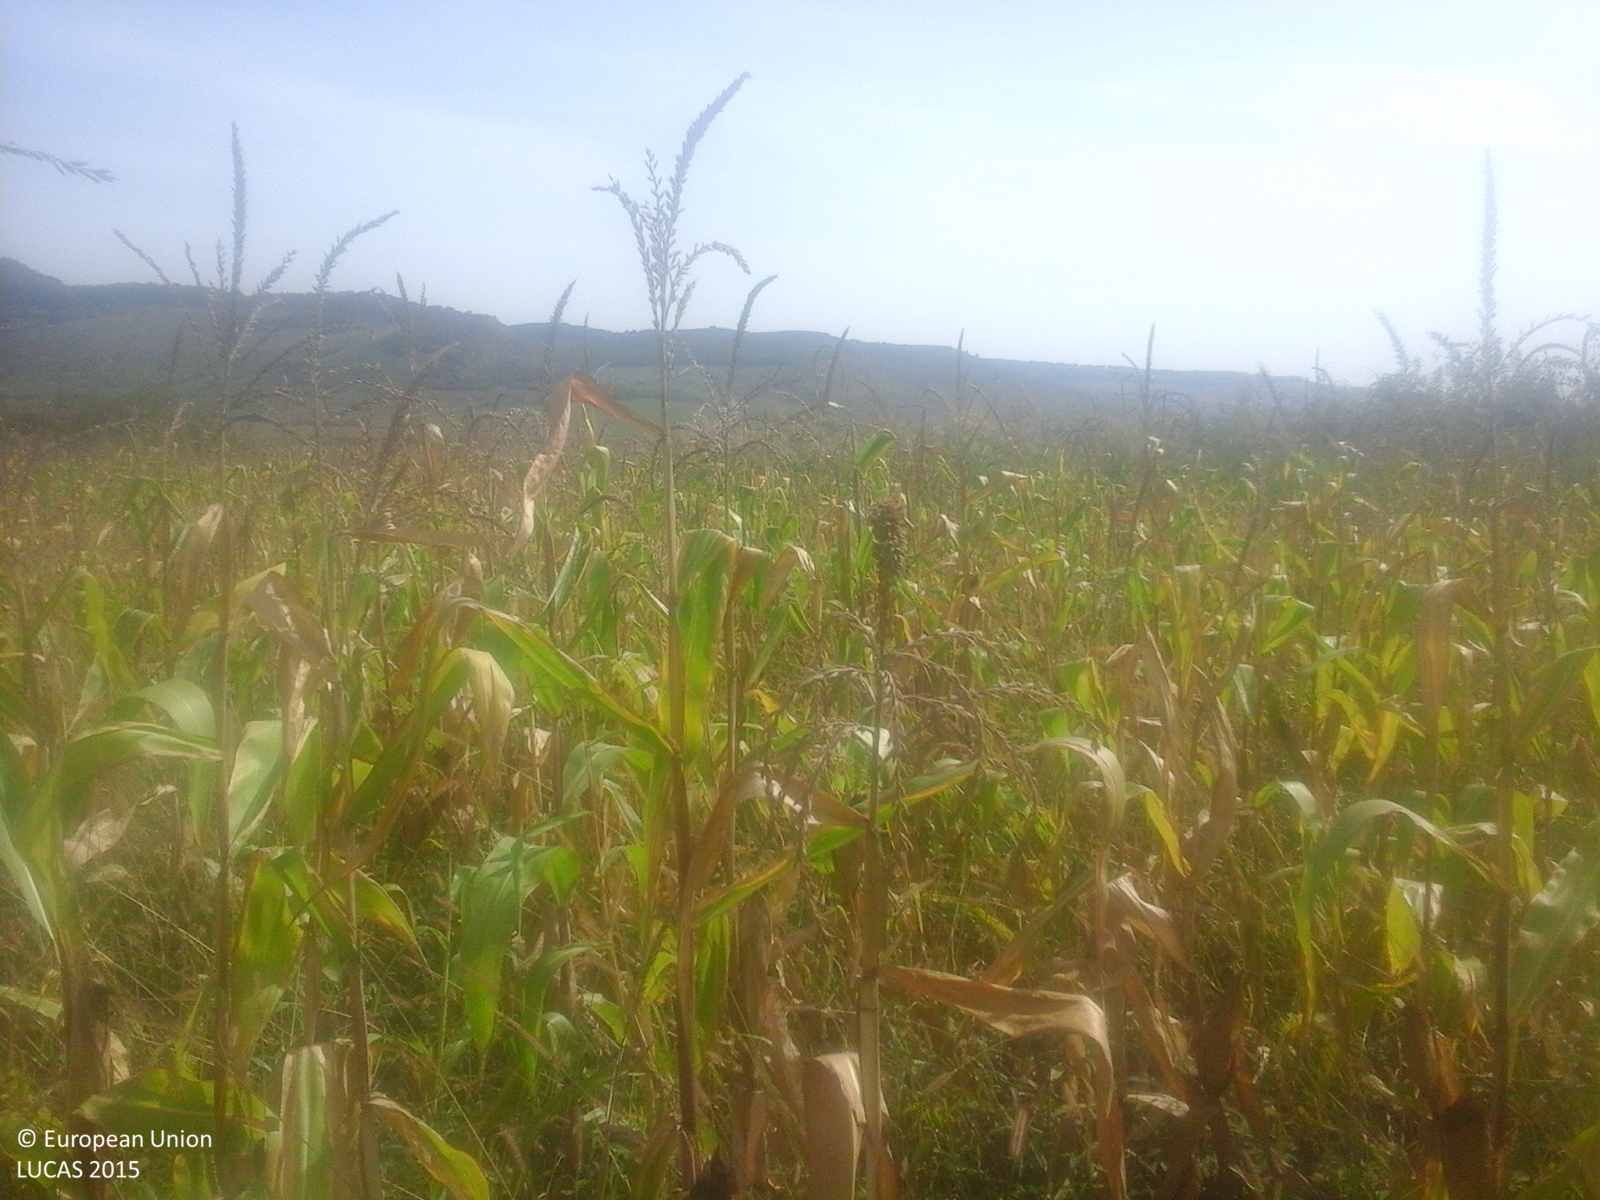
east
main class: Cropland
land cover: Maize
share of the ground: > 75 %
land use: Agriculture (excluding fallow land and kitchen gardens)
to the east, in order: Maize; Shruby margins; Ditches and canals; Abandoned hedges; Tracks; Other leguminous and mixtures for fodder; Spontaneously vegetated surfaces; Lucerne; Maize; Potatoes; Tracks; Shruby margins; Abandoned hedges; Inland fresh running water; Spontaneously vegetated surfaces; Shrubland with sparse tree cover
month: September
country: RO
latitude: 47.0421
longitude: 24.3410
